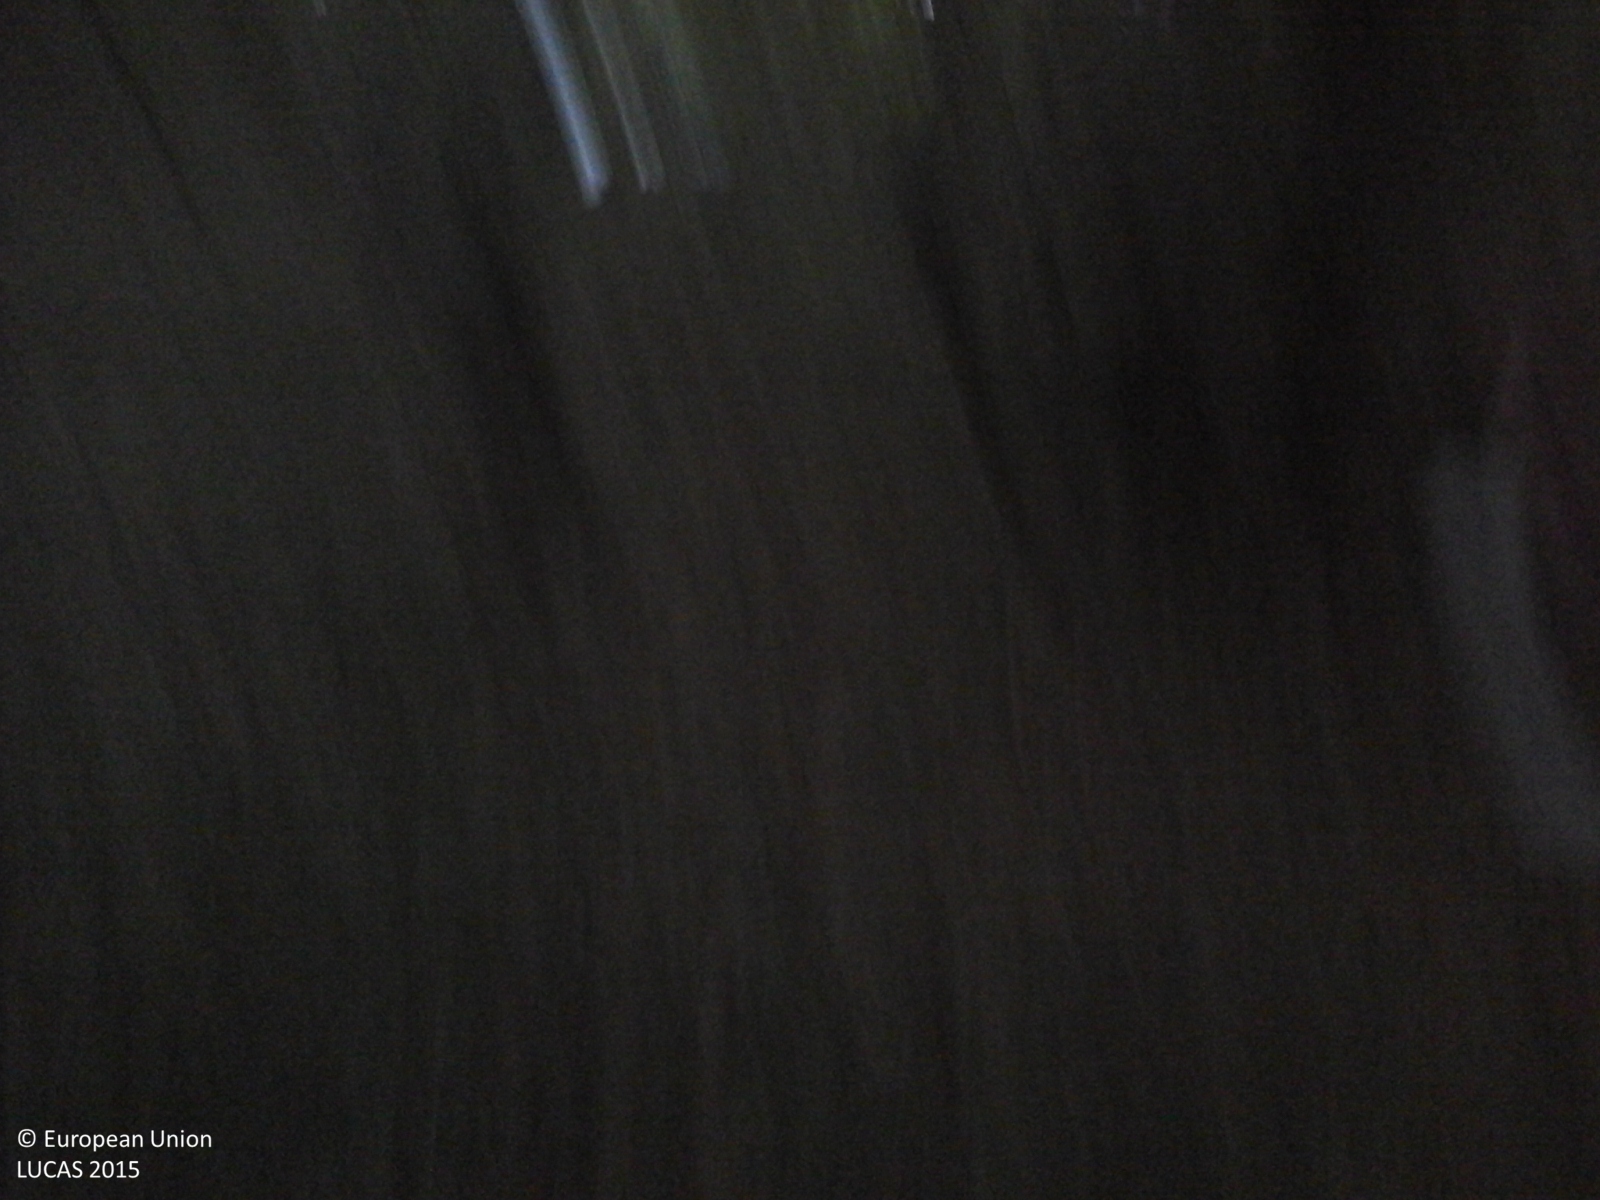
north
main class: Woodland
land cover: Broadleaved woodland
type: thermophilous deciduous forest
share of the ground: > 75 %
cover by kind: broadleaved forest trees 80 %, shrubs 10 %, herbaceous plants 10 %
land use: Semi-natural and natural areas not in use
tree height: > 5 m
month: September
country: IT
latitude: 44.2278
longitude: 8.2639
